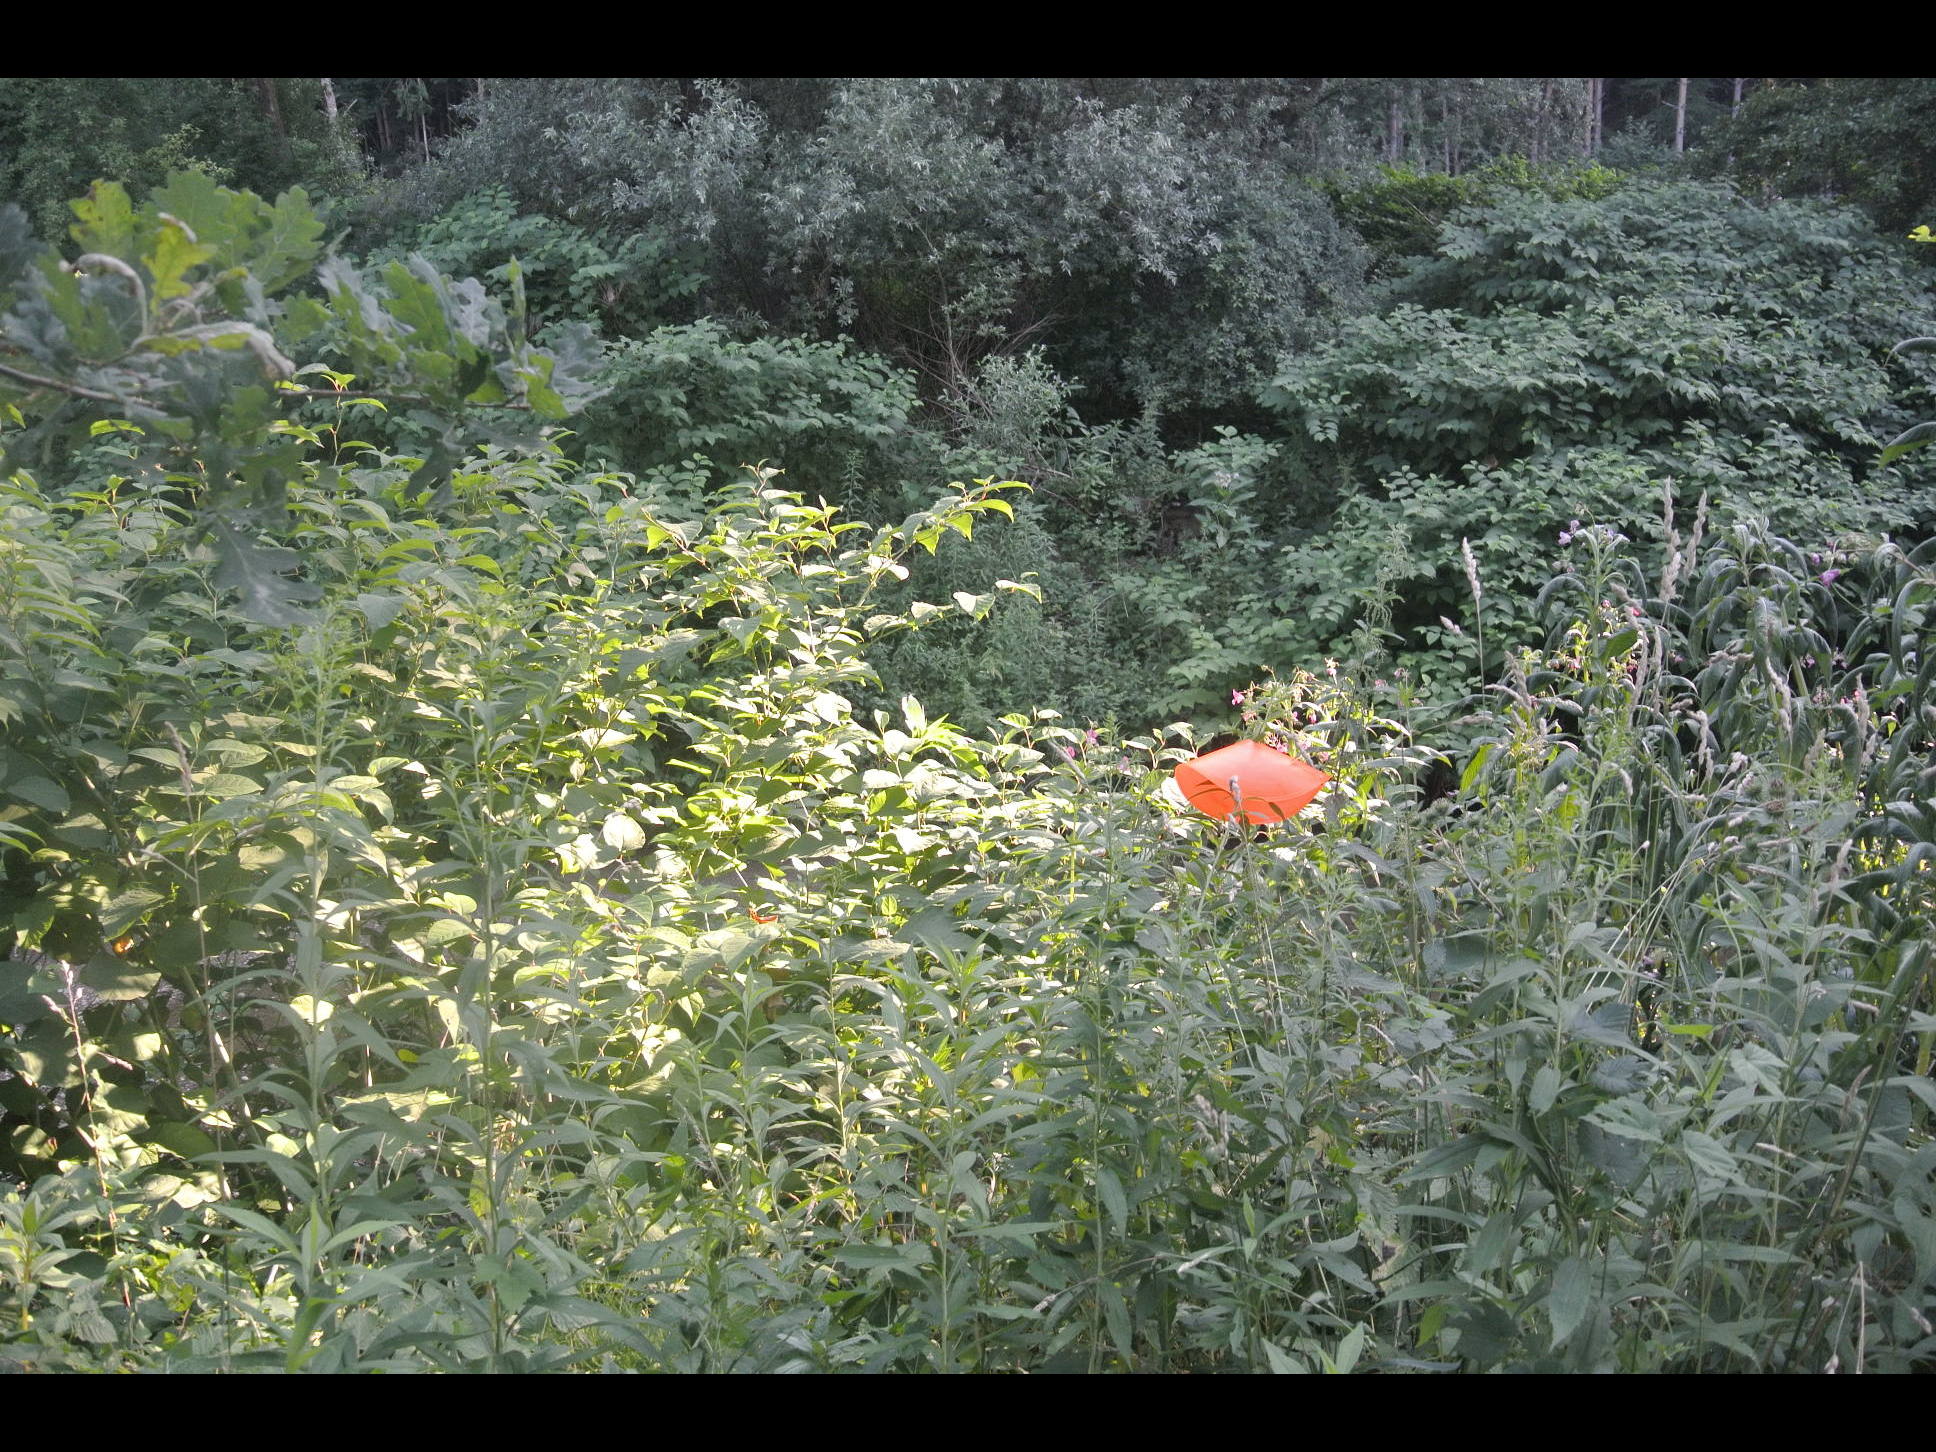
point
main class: Woodland
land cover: Broadleaved woodland
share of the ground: > 75 %
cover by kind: broadleaved forest trees 90 %, shrubs 5 %, herbaceous plants 5 %
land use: Forestry
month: July
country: AT
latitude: 47.5083
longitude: 16.4964
